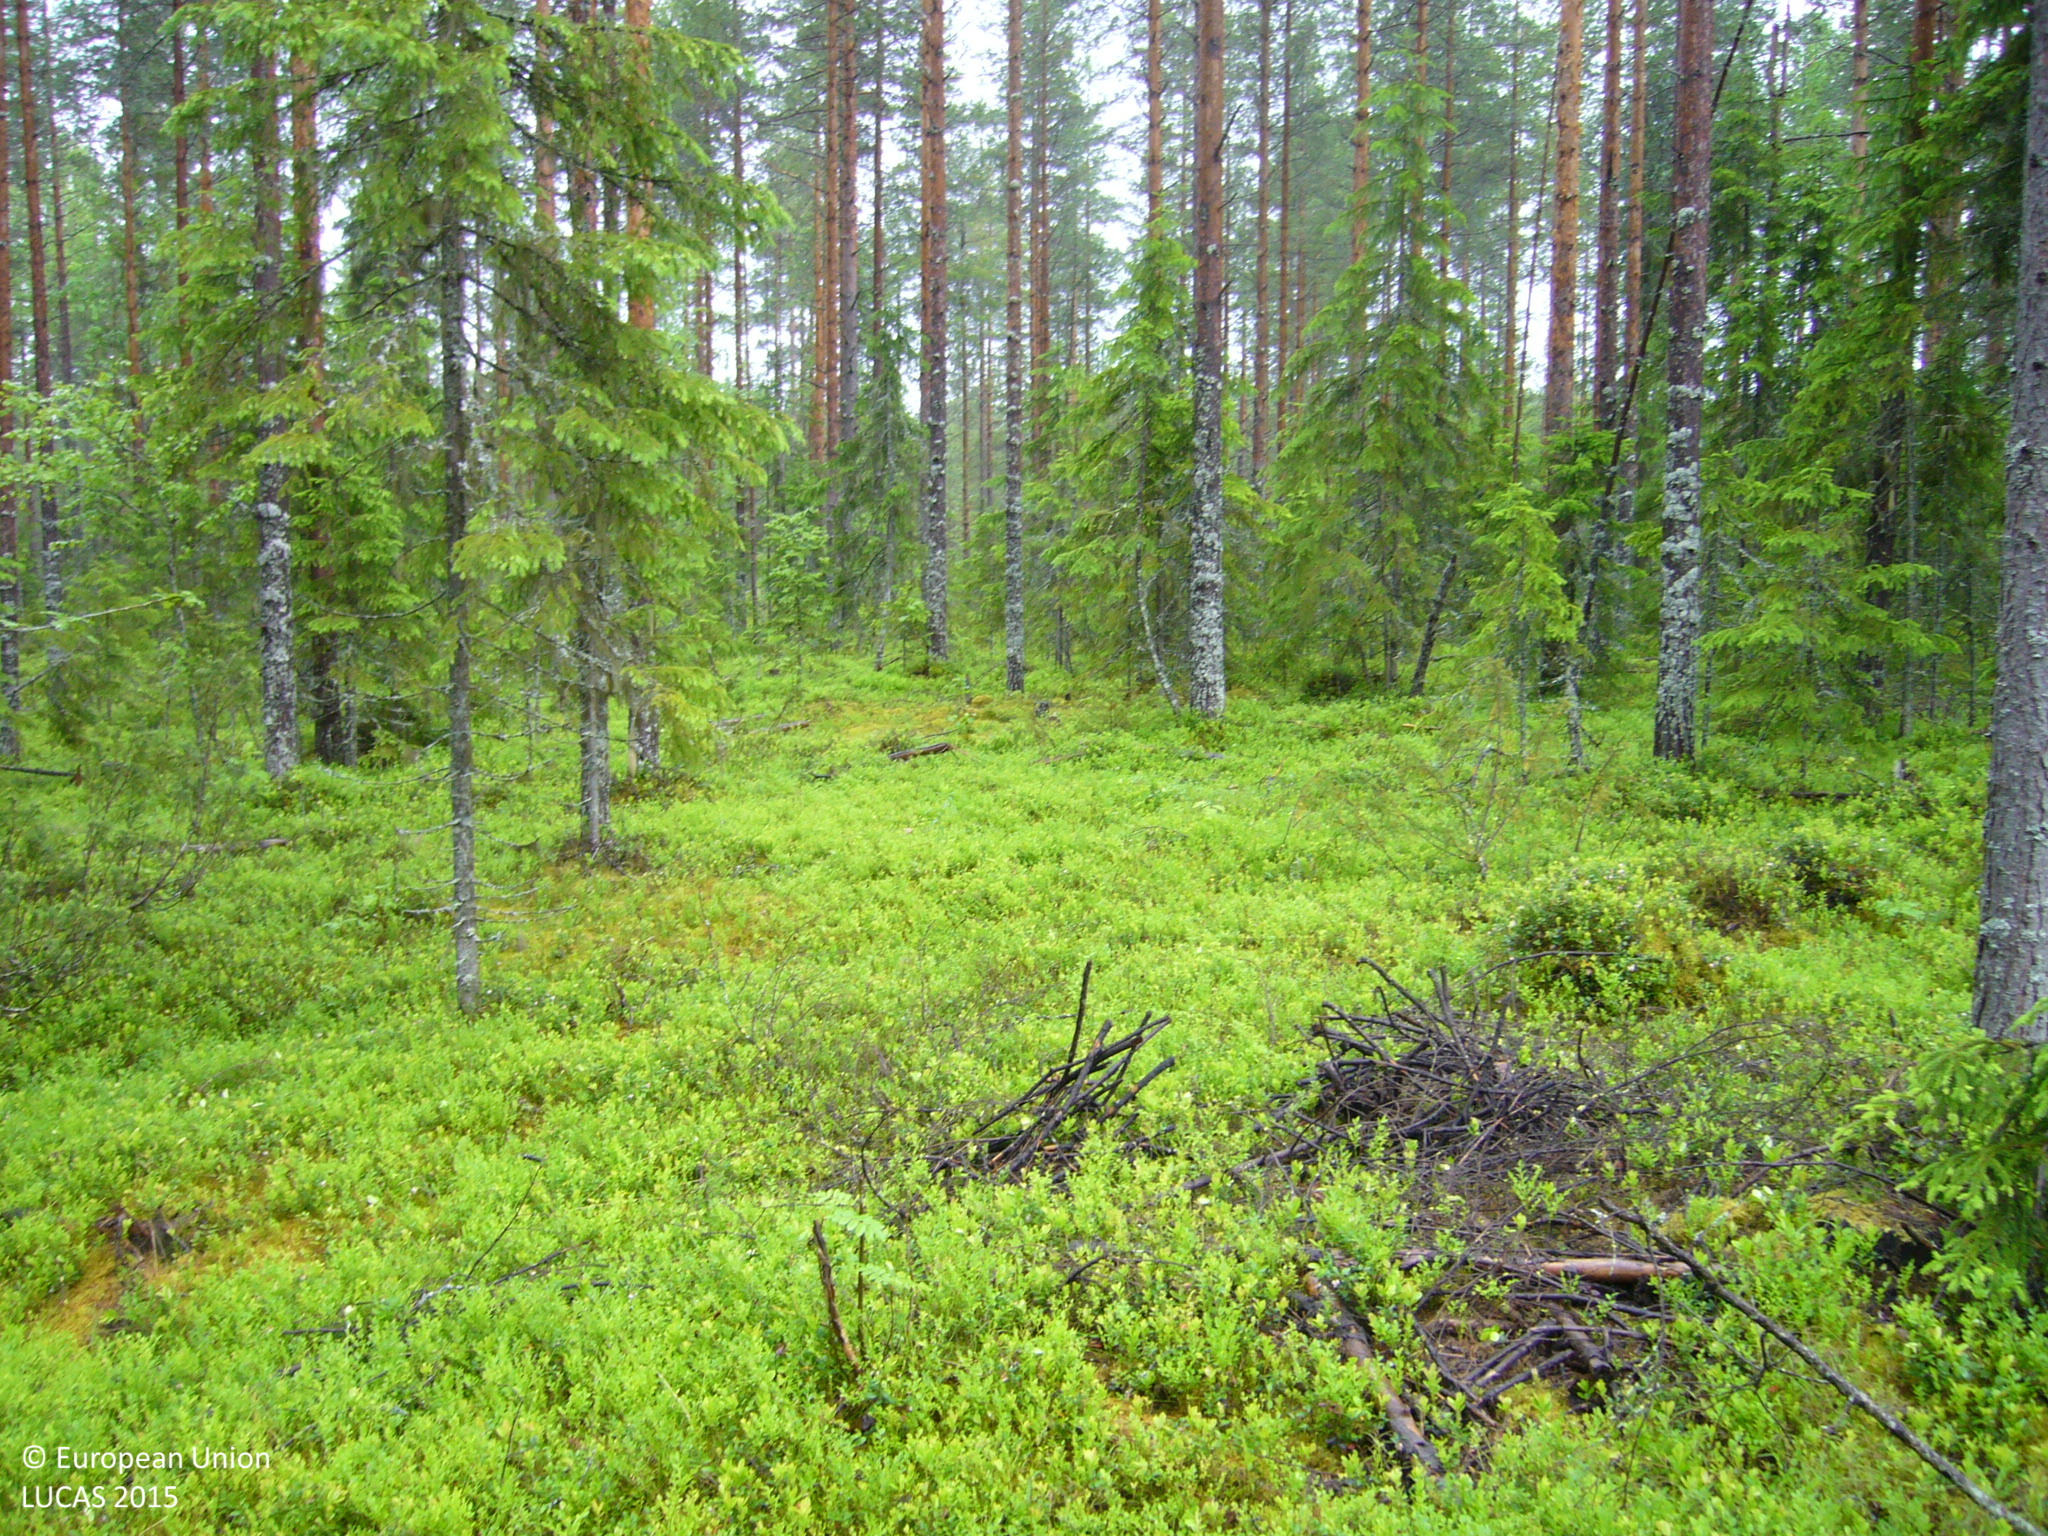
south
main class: Woodland
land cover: Pine dominated coniferous woodland
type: boreal forest
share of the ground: 50 - 75 %
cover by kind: coniferous forest trees 60 %, shrubs 40 %
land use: Forestry
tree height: > 5 m
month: June
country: FI
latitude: 63.7484
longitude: 26.1431
